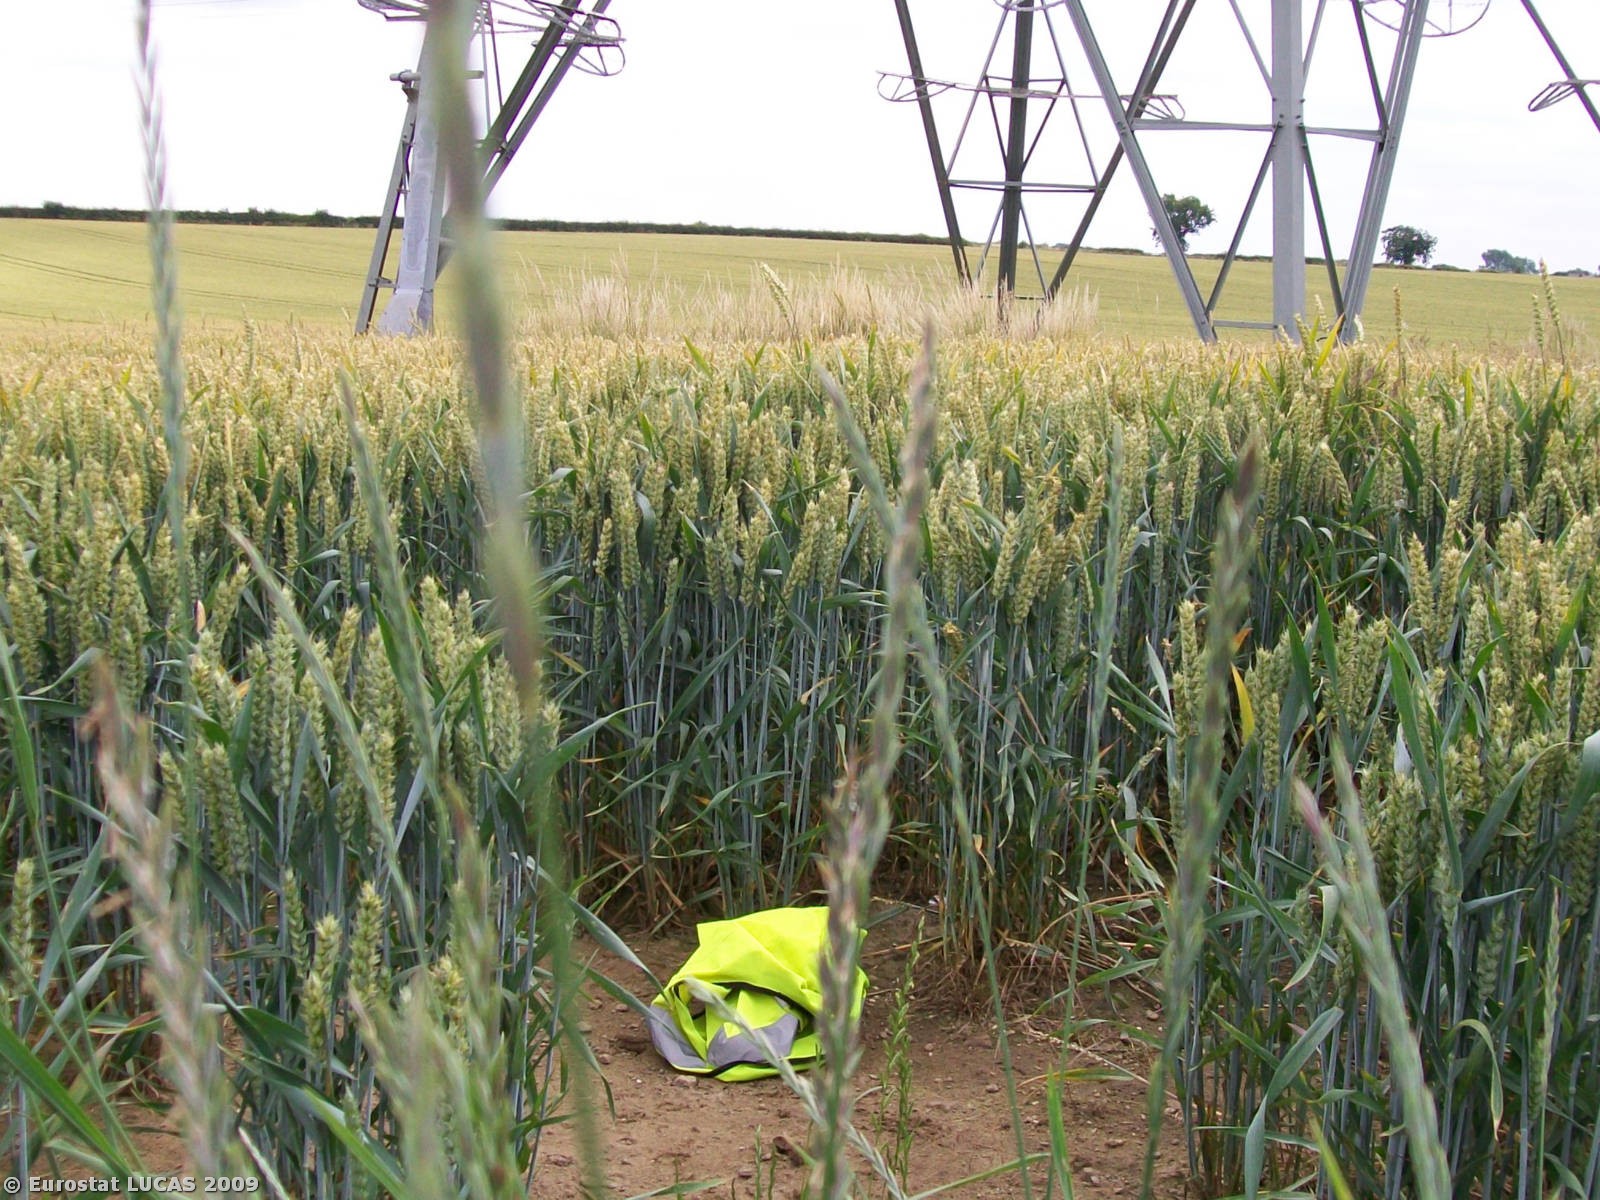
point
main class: Cropland
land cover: Common wheat
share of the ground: > 75 %
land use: Agriculture (excluding fallow land and kitchen gardens)
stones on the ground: < 10 %
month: July
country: GB
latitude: 53.7007
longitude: -1.3628
